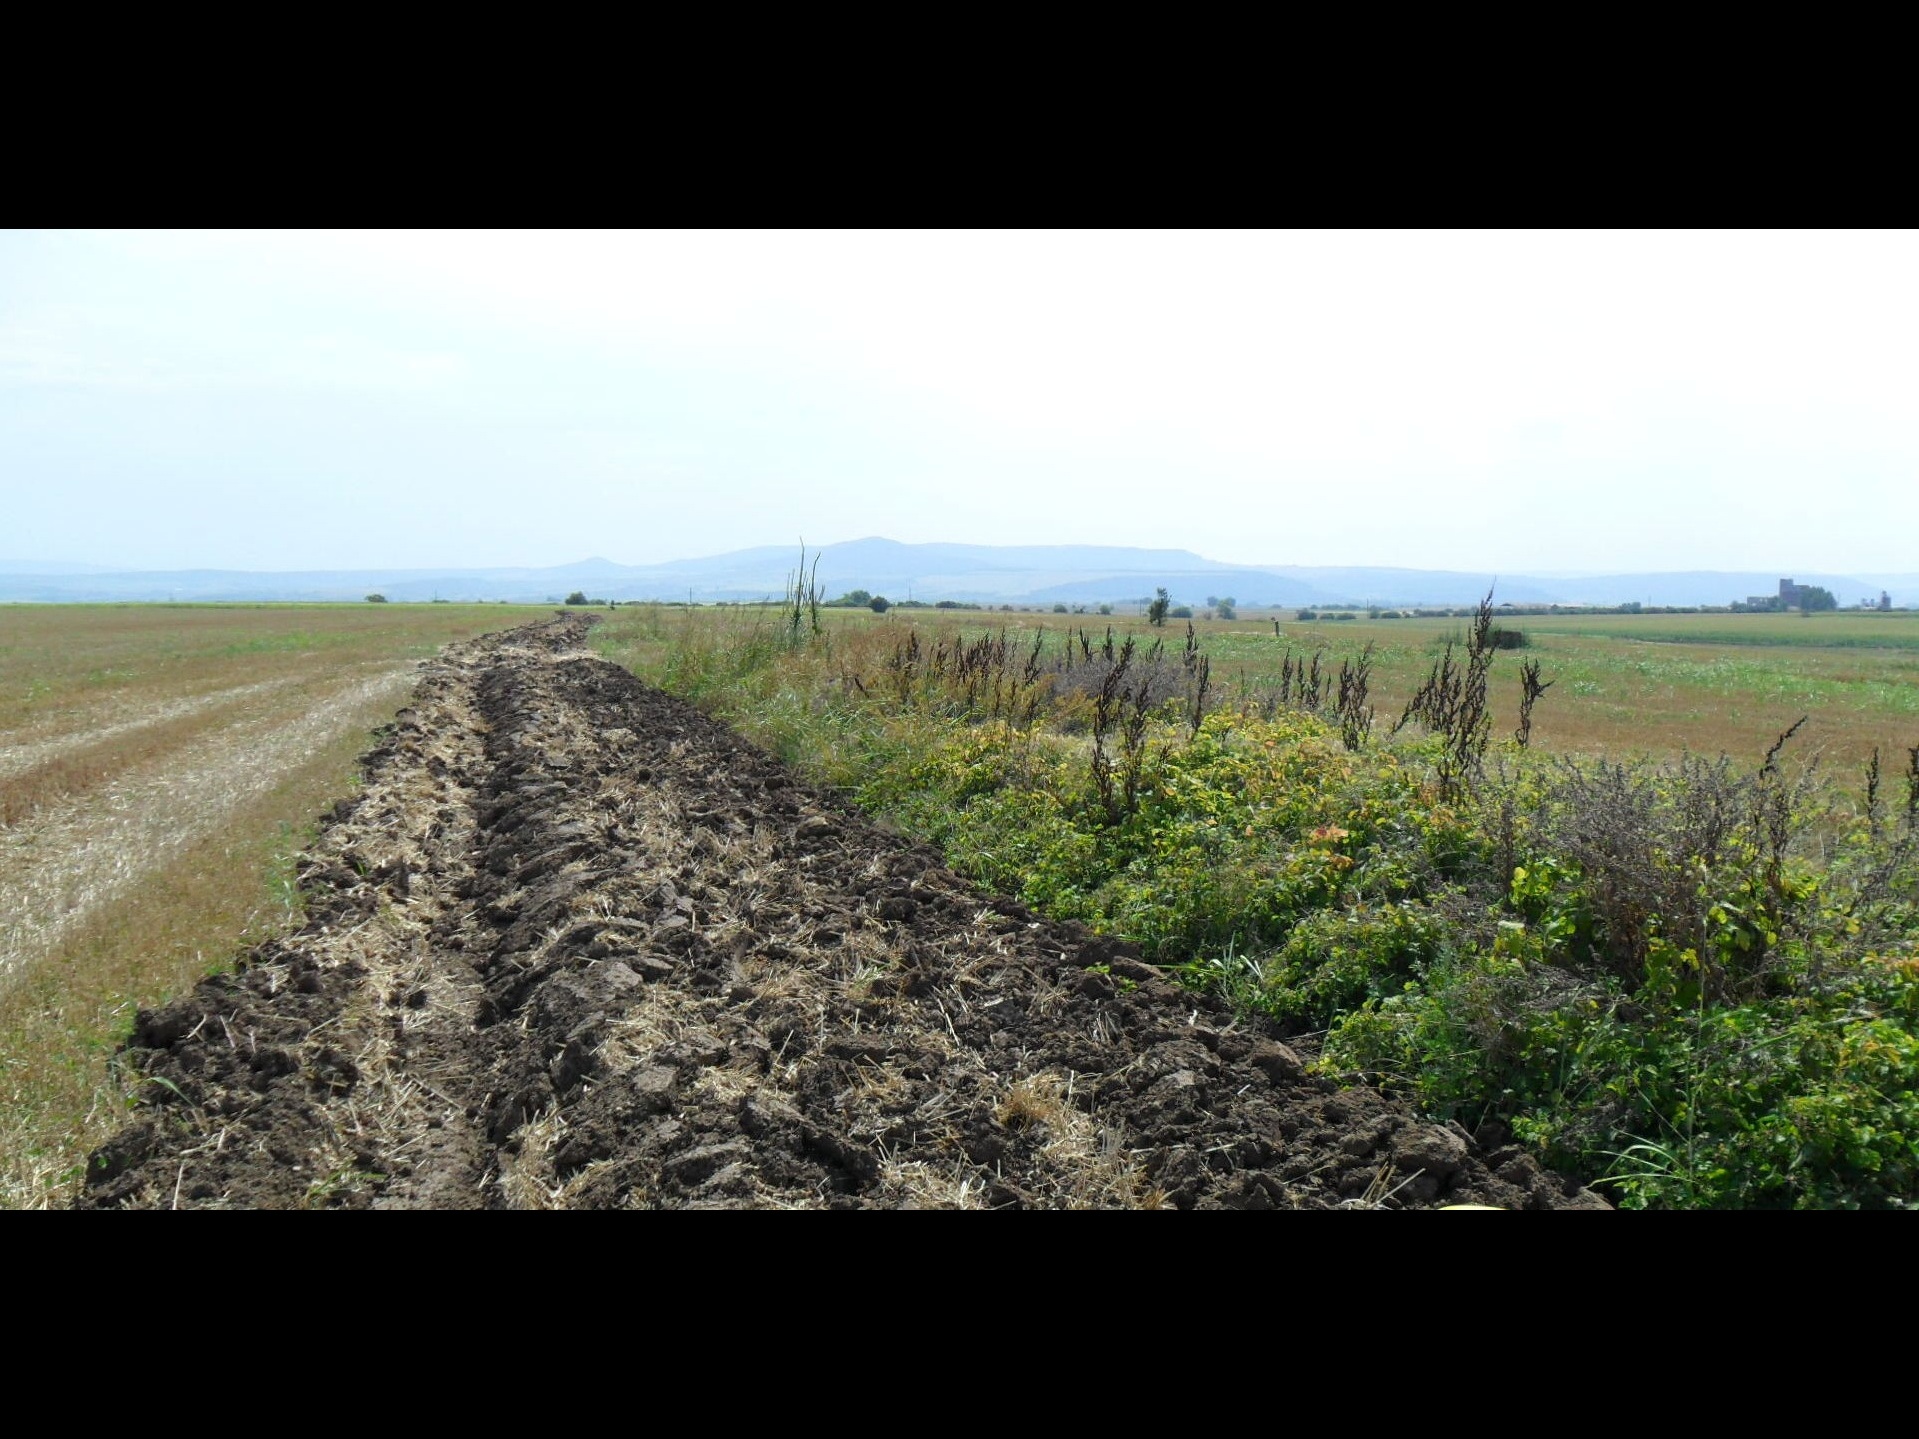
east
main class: Cropland
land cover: Barley
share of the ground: > 75 %
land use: Agriculture (excluding fallow land and kitchen gardens)
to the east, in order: Grass margins; Barley
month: August
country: BG
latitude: 43.3752
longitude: 26.2277
